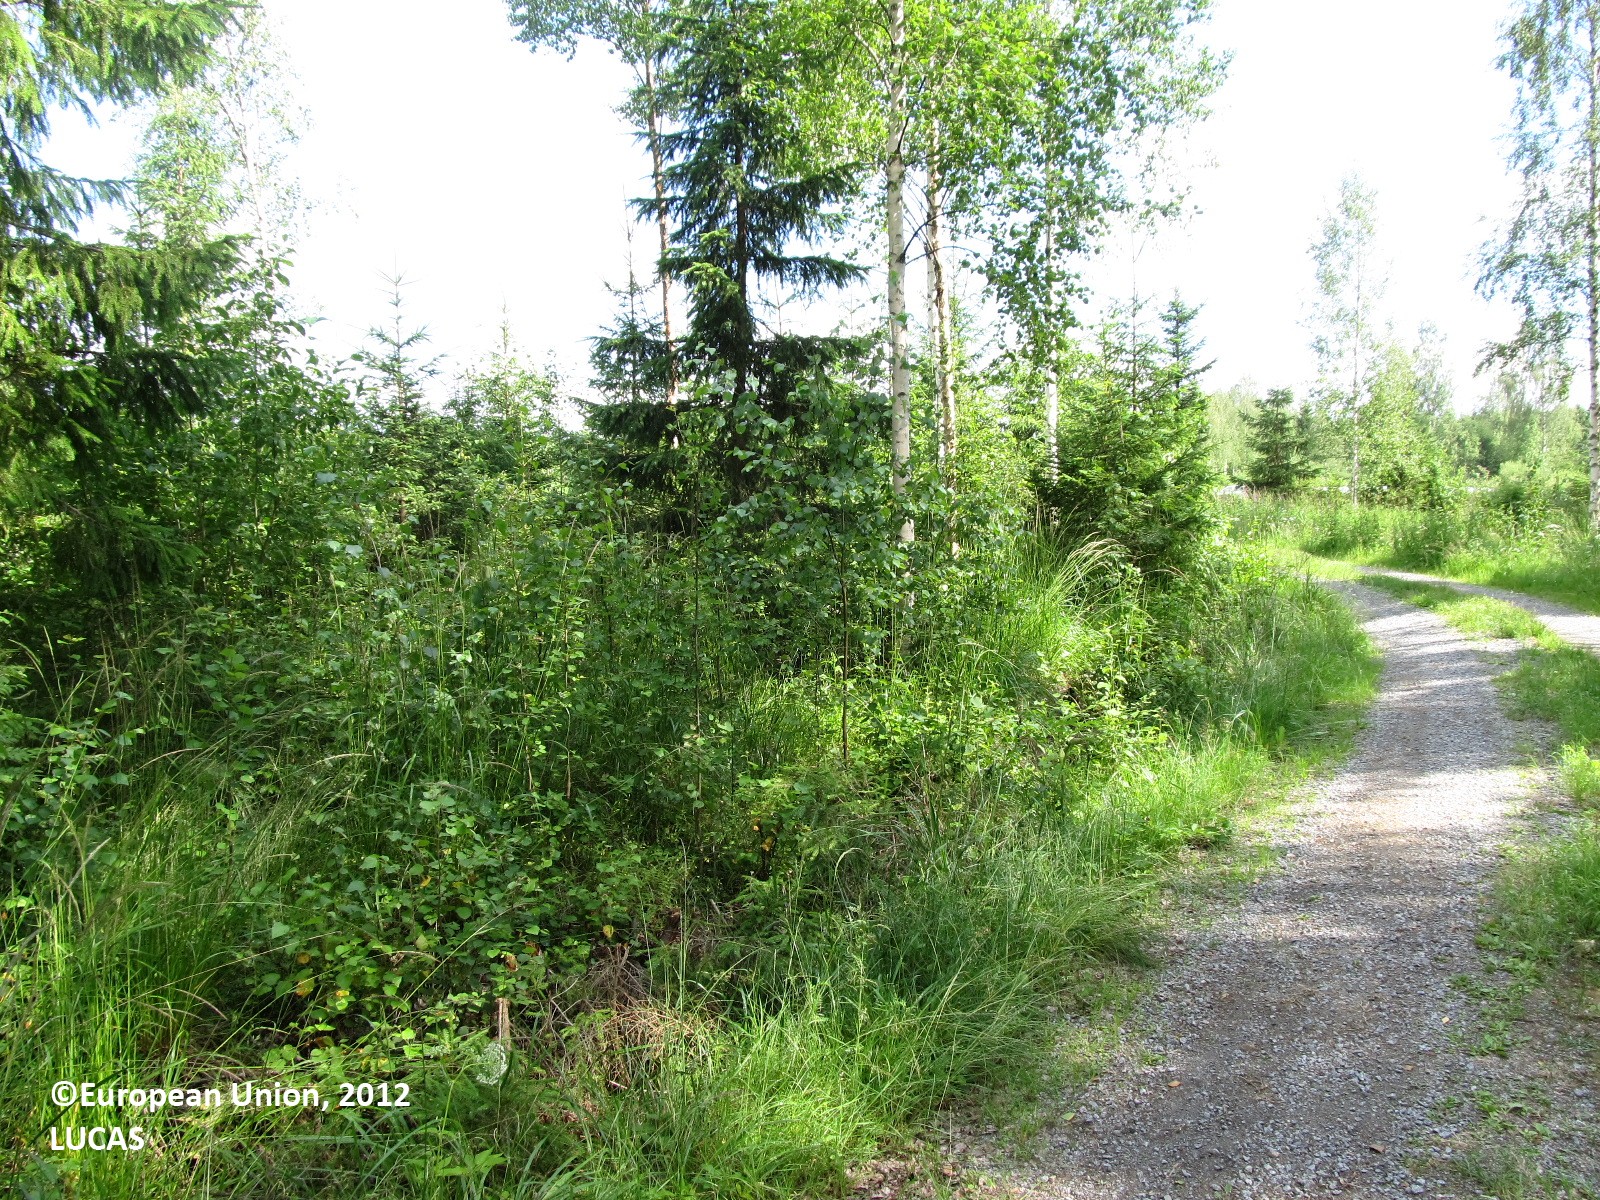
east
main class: Woodland
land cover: Spruce dominated mixed woodland
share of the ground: 25 - 50 %
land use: Forestry
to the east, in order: Spruce dominated mixed woodland; Ditches and canals; Temporary grasslands; Ditches and canals; Temporary grasslands
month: July
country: FI
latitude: 61.9323
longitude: 28.3585
